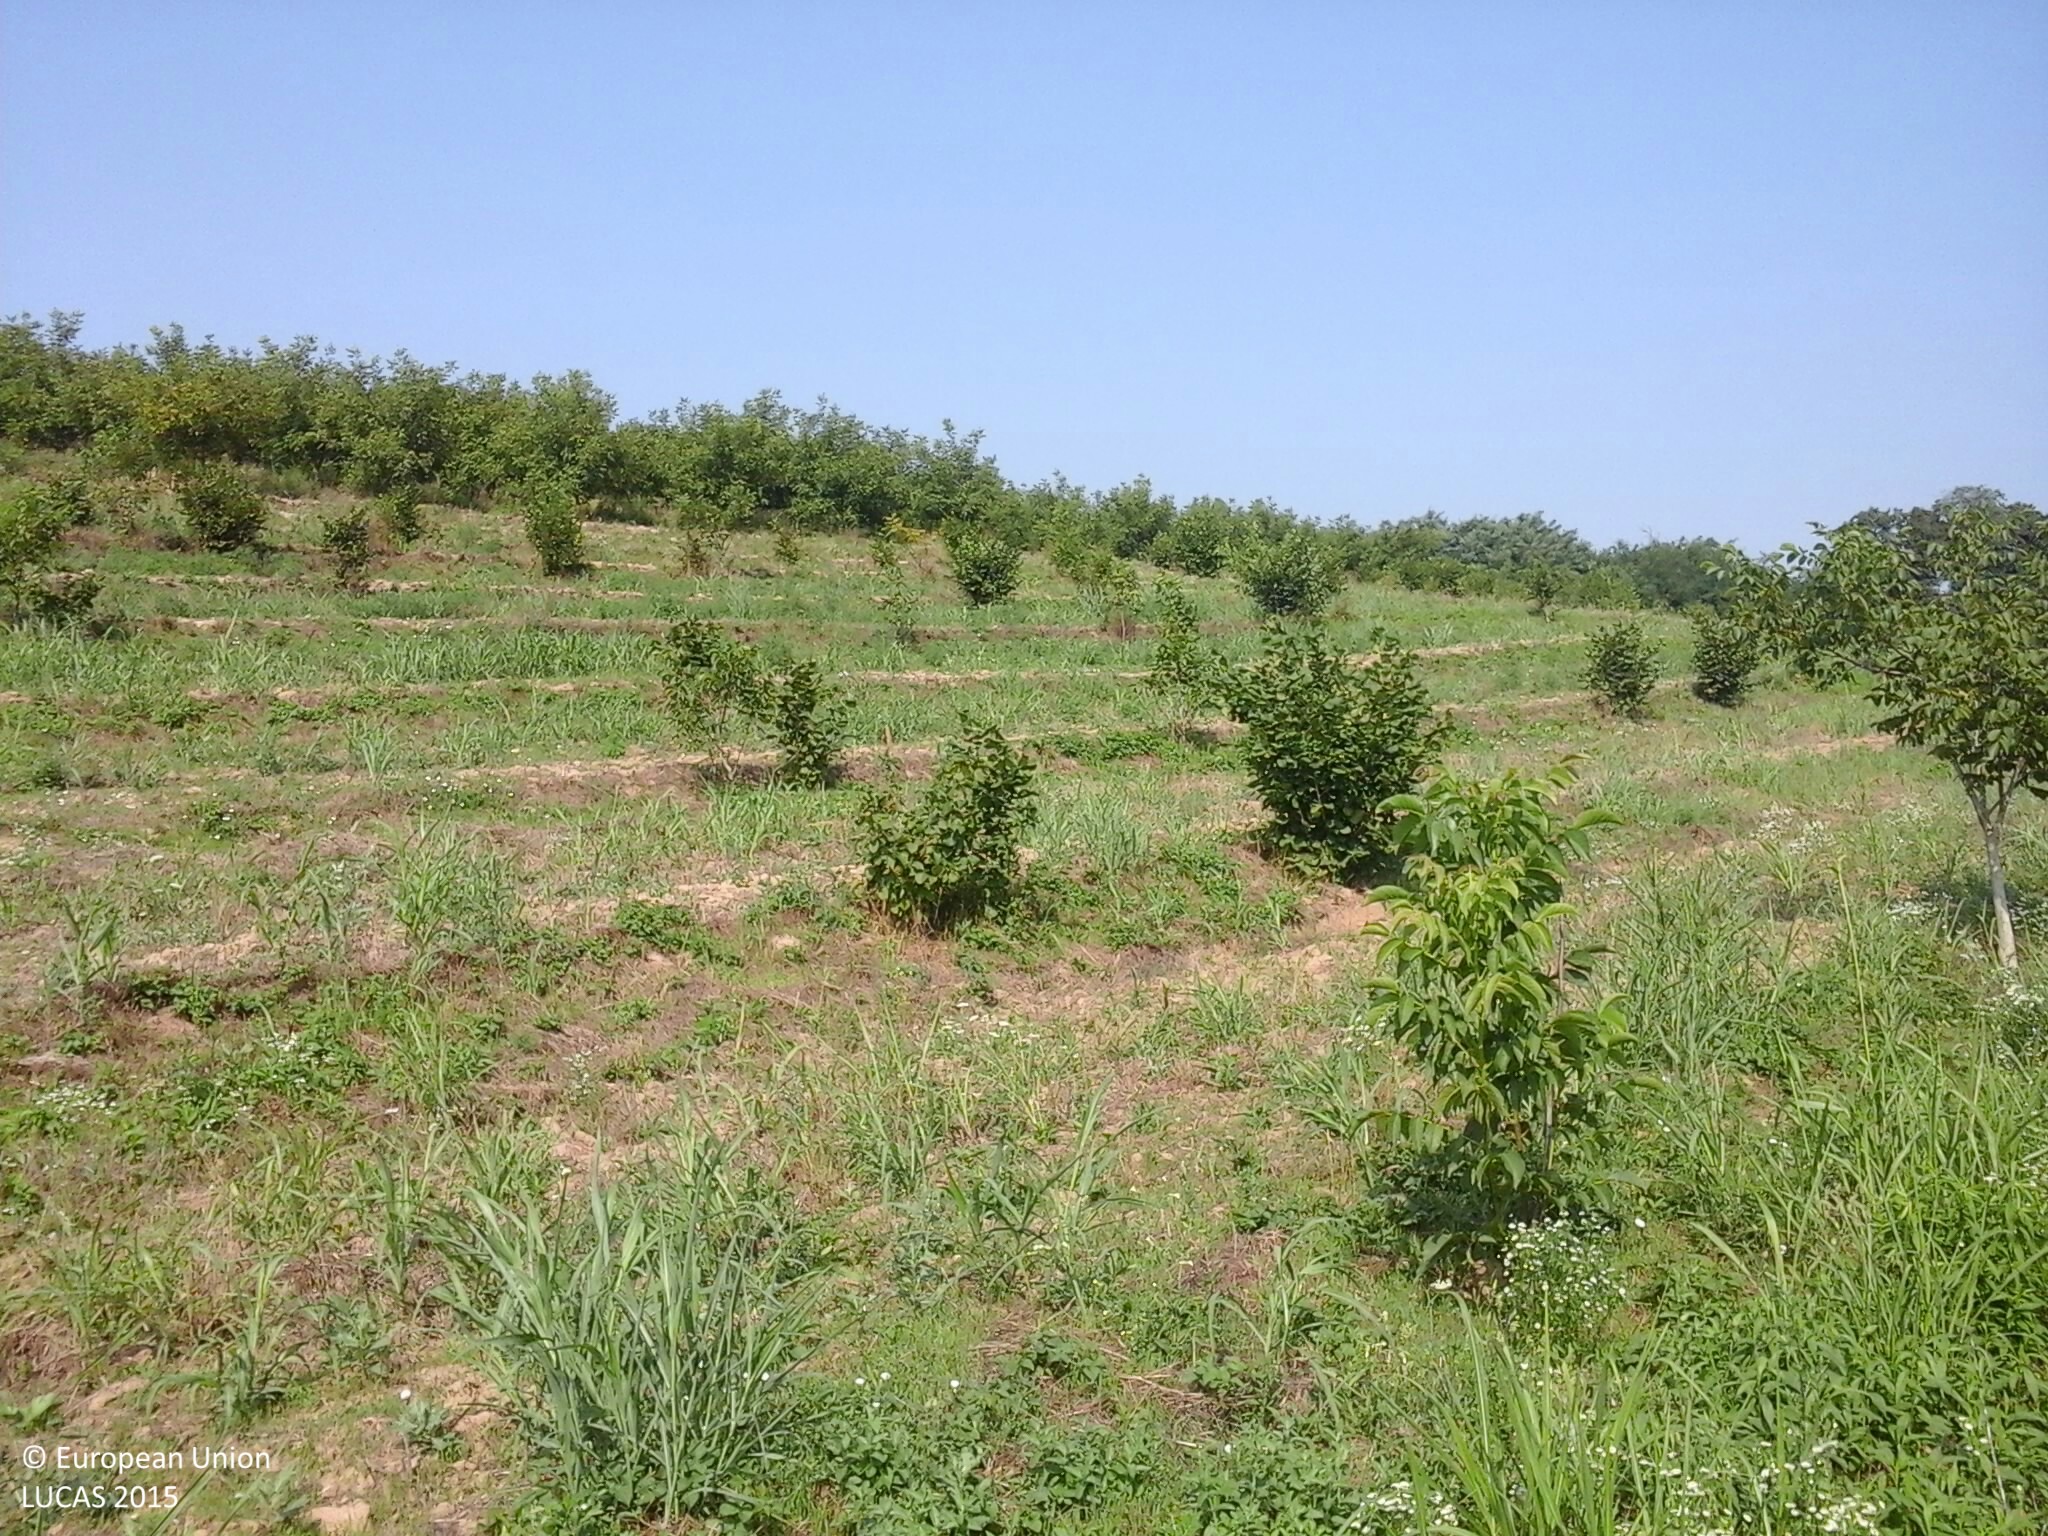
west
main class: Cropland
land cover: Maize
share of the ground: > 75 %
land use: Agriculture (excluding fallow land and kitchen gardens)
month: August
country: HU
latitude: 46.6171
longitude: 17.9338
